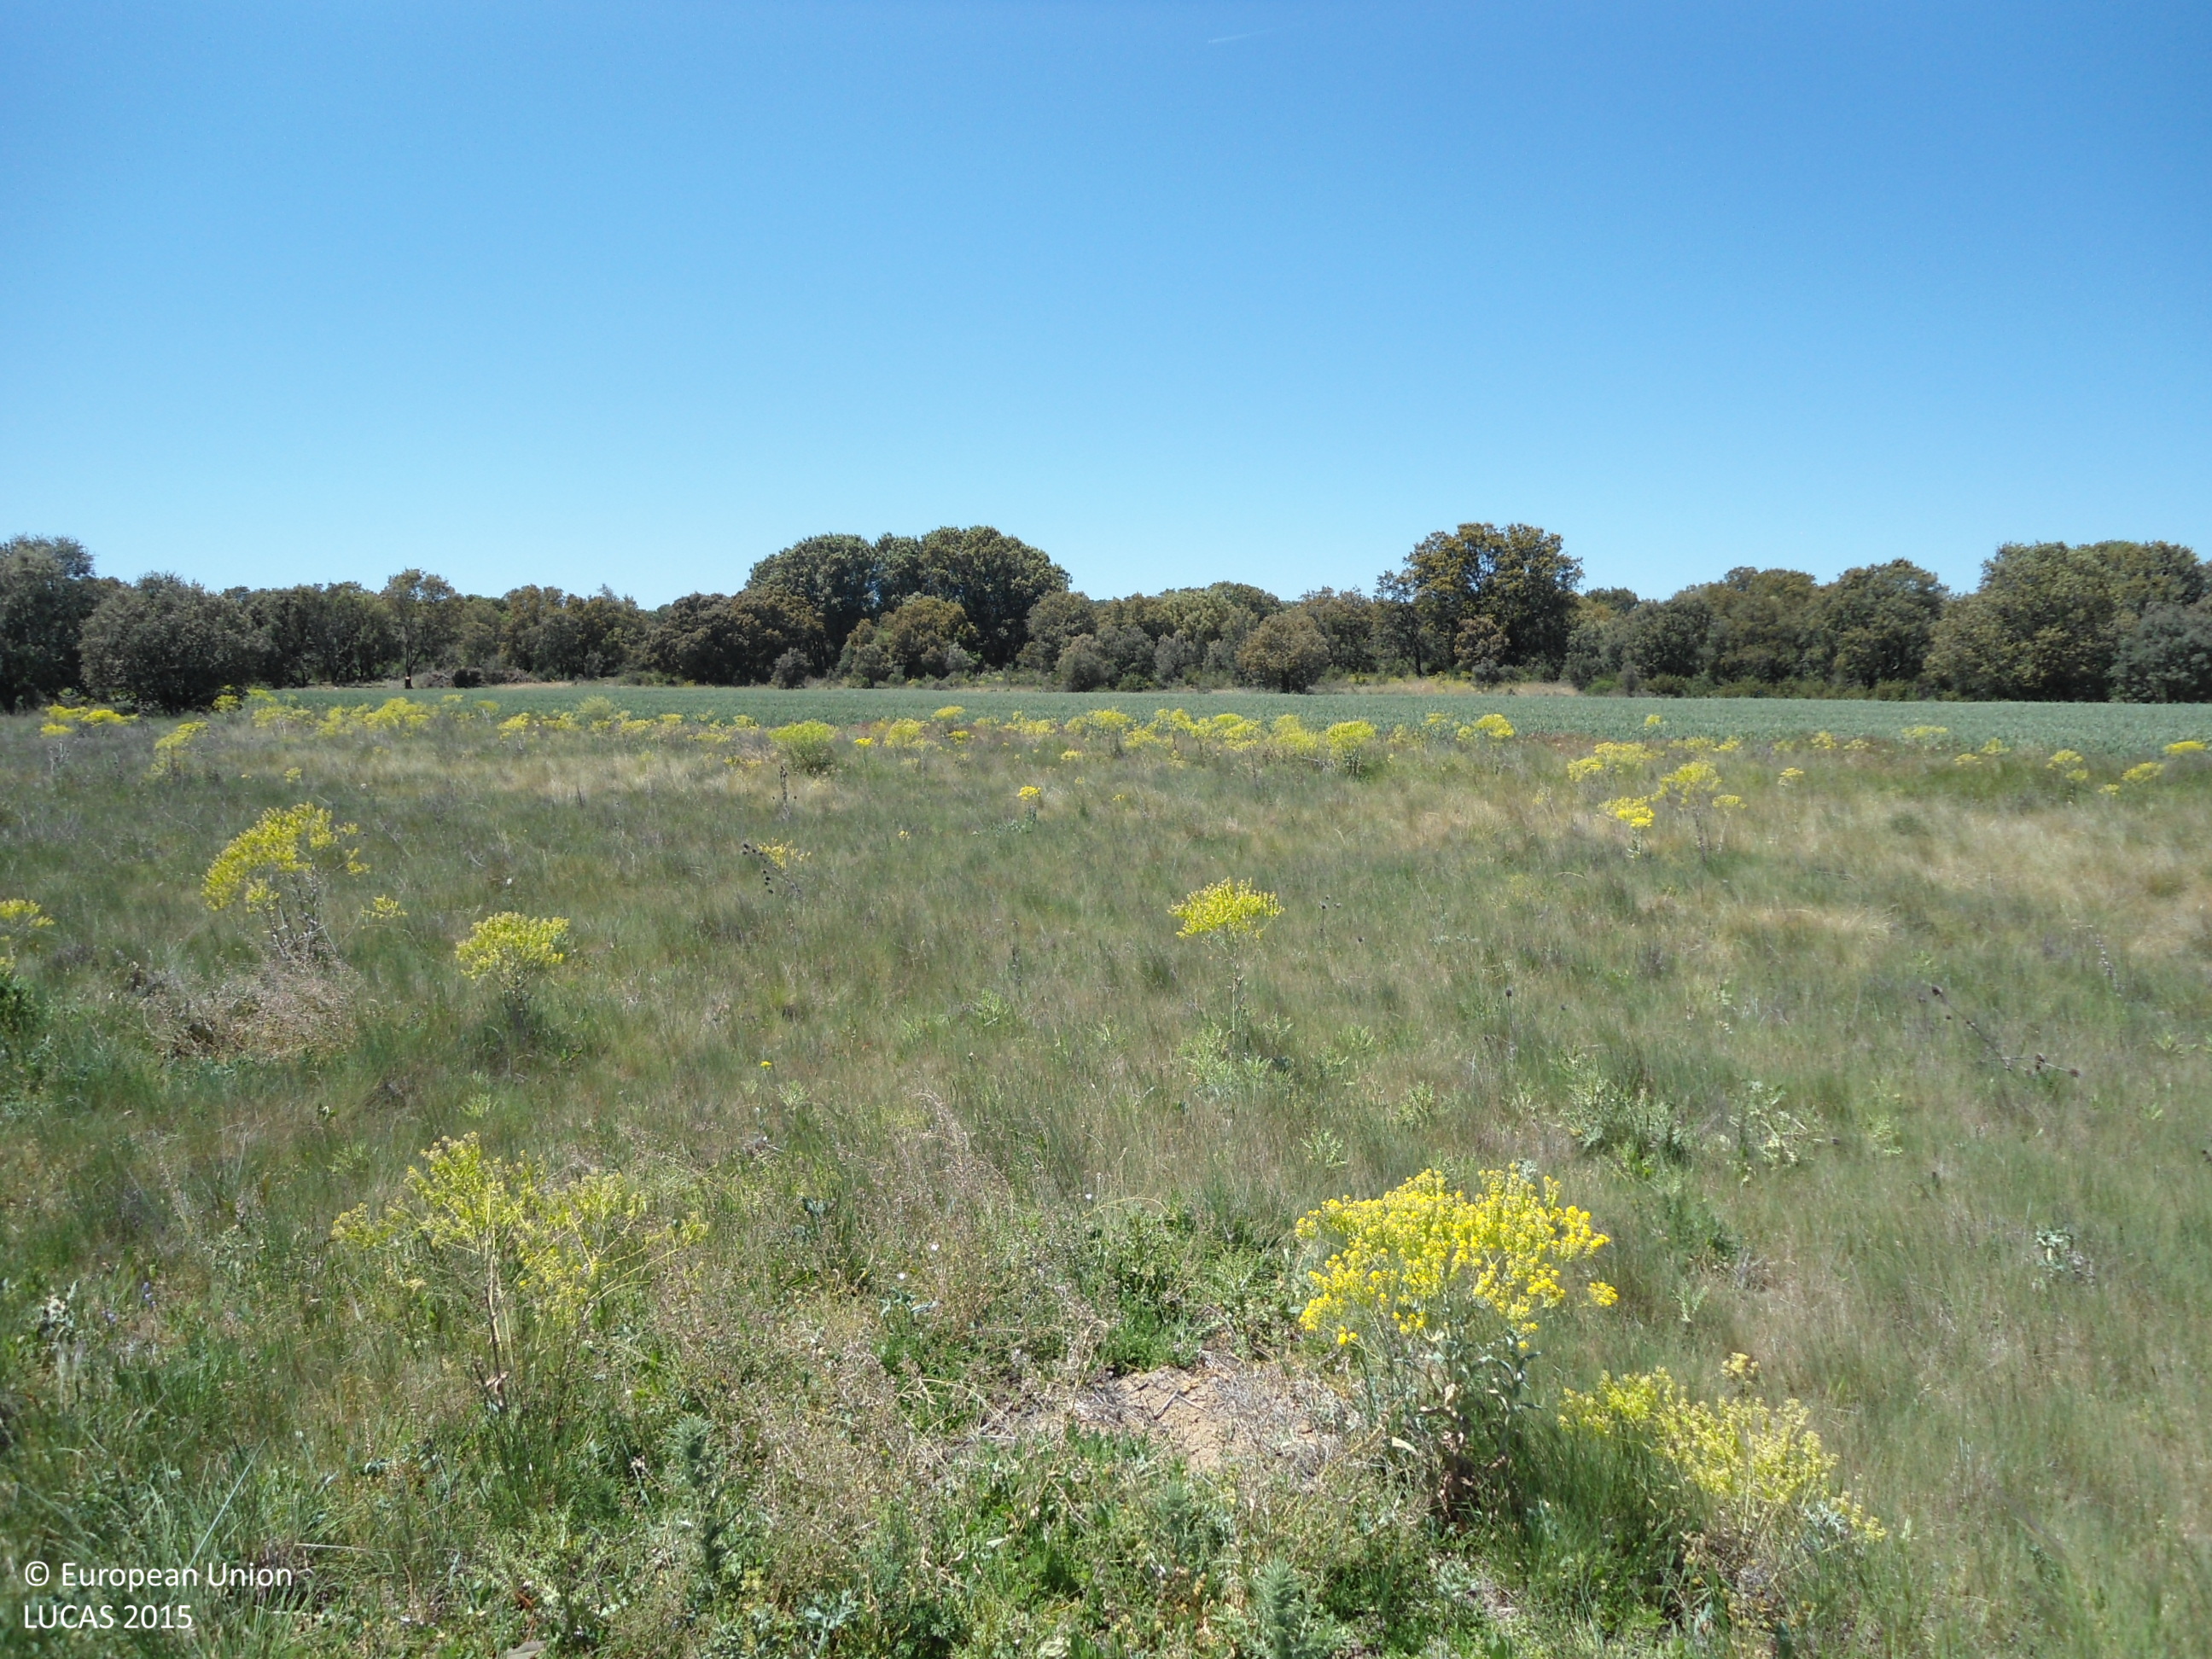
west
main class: Grassland
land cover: Grassland without tree/shrub cover
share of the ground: > 75 %
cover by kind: herbaceous plants 100 %
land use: Semi-natural and natural areas not in use
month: May
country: ES
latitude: 42.0971
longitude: -5.9504
